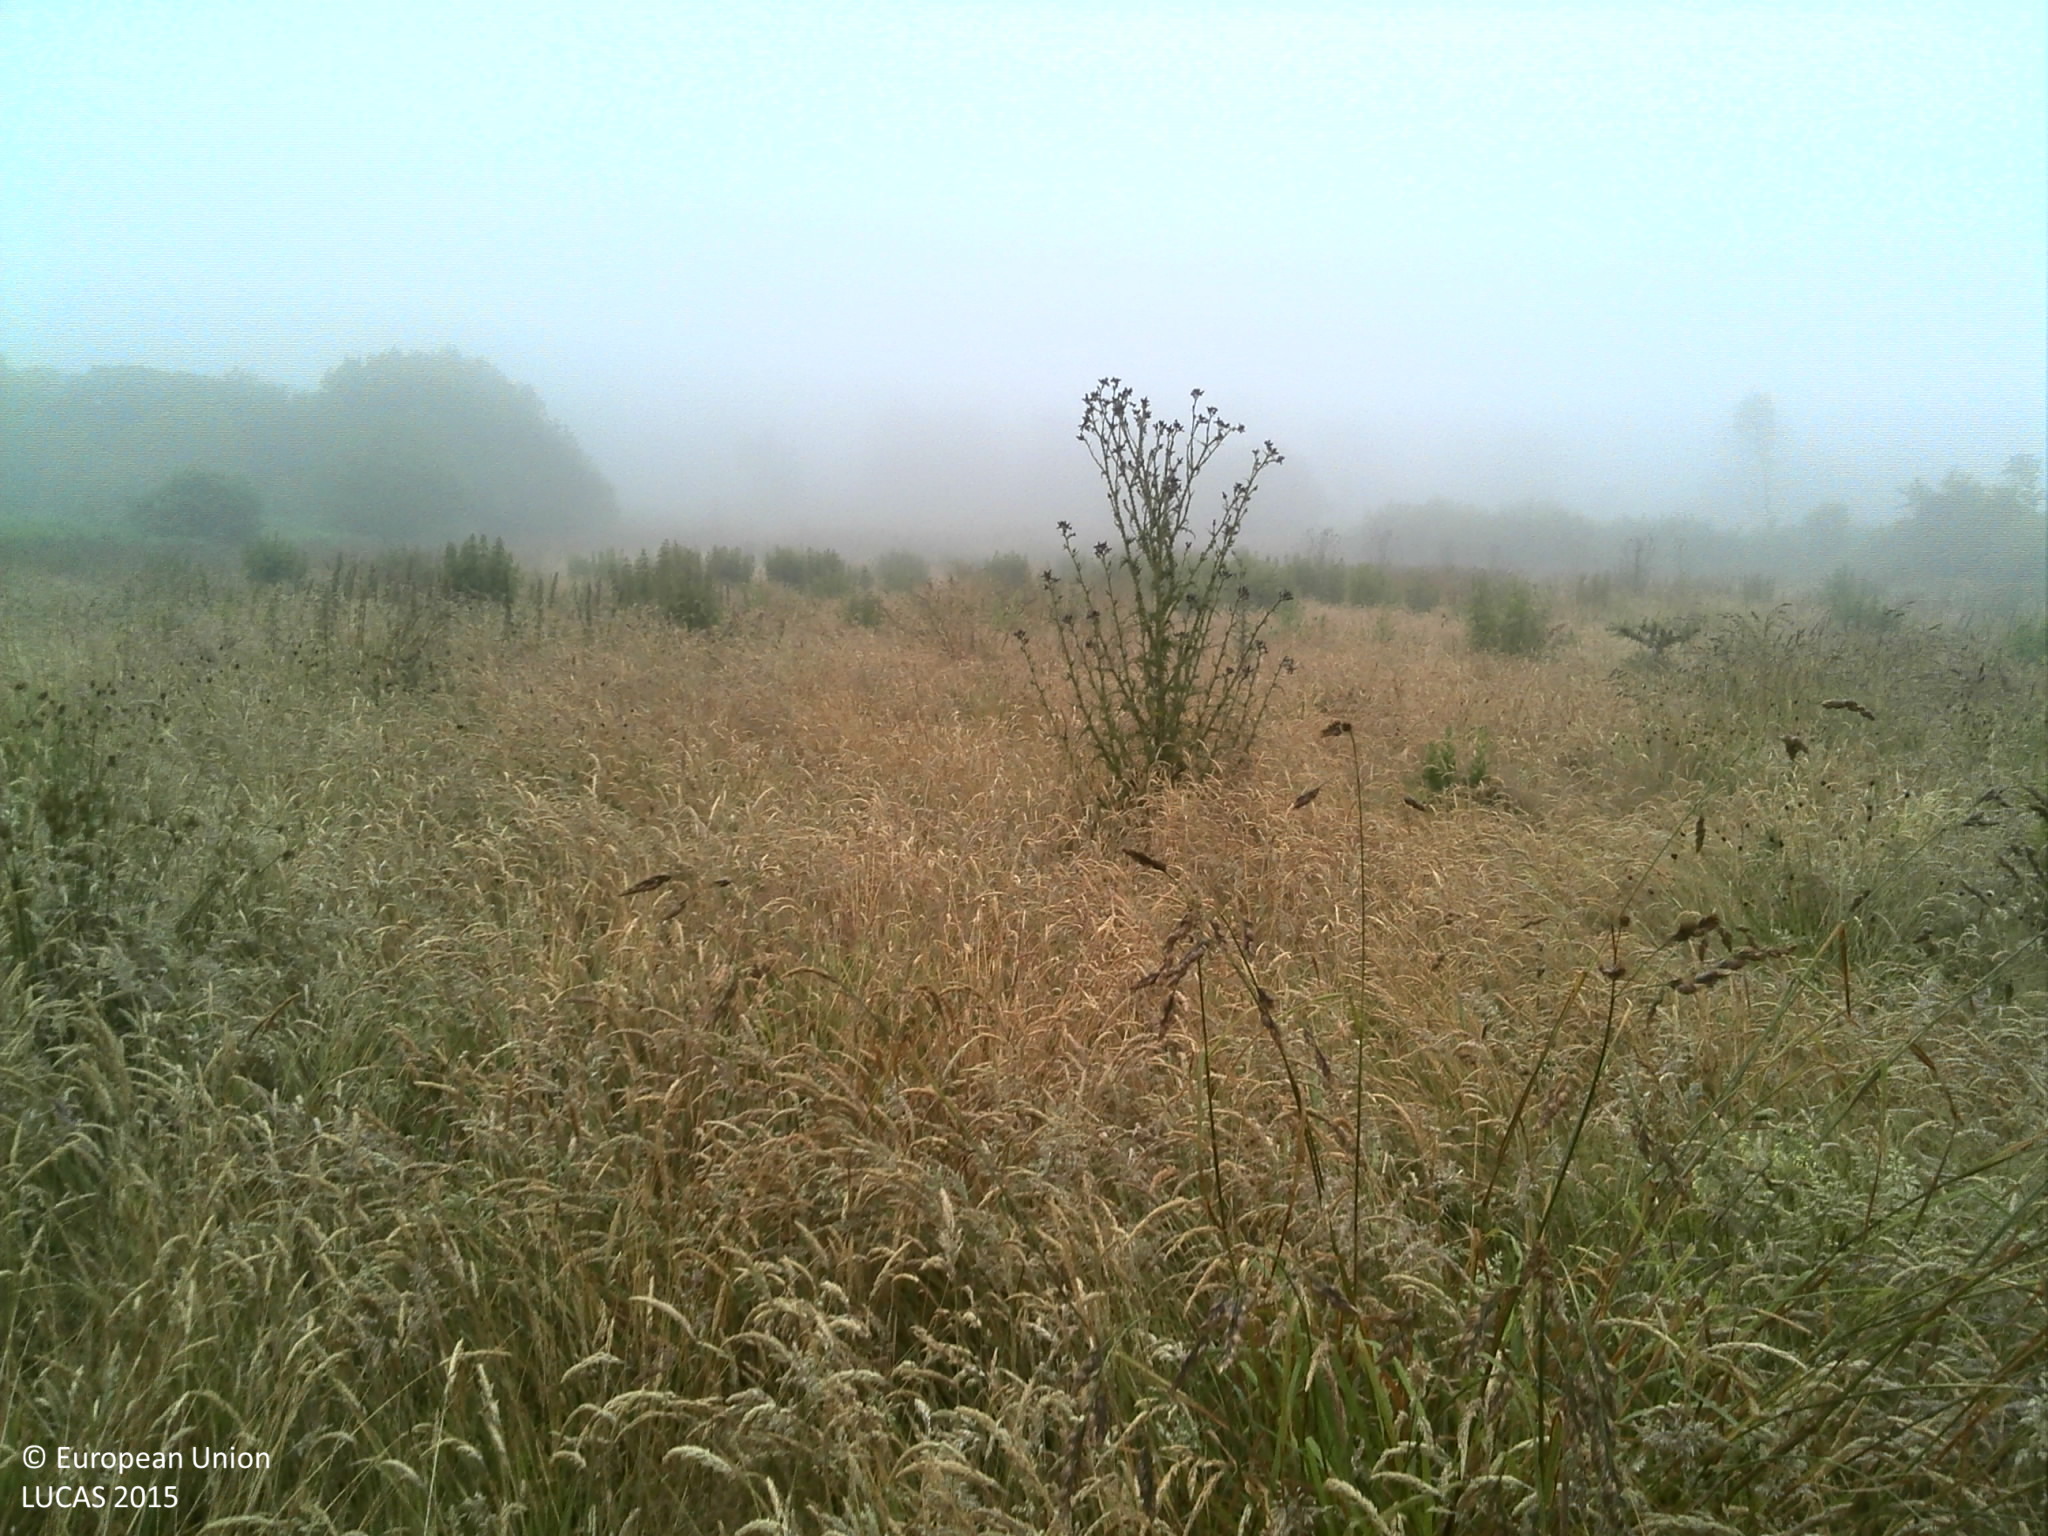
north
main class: Grassland
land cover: Grassland without tree/shrub cover
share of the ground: > 75 %
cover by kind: herbaceous plants 100 %
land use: Agriculture (excluding fallow land and kitchen gardens)
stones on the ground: < 10 %
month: July
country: FR
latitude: 48.2073
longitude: -4.2348
